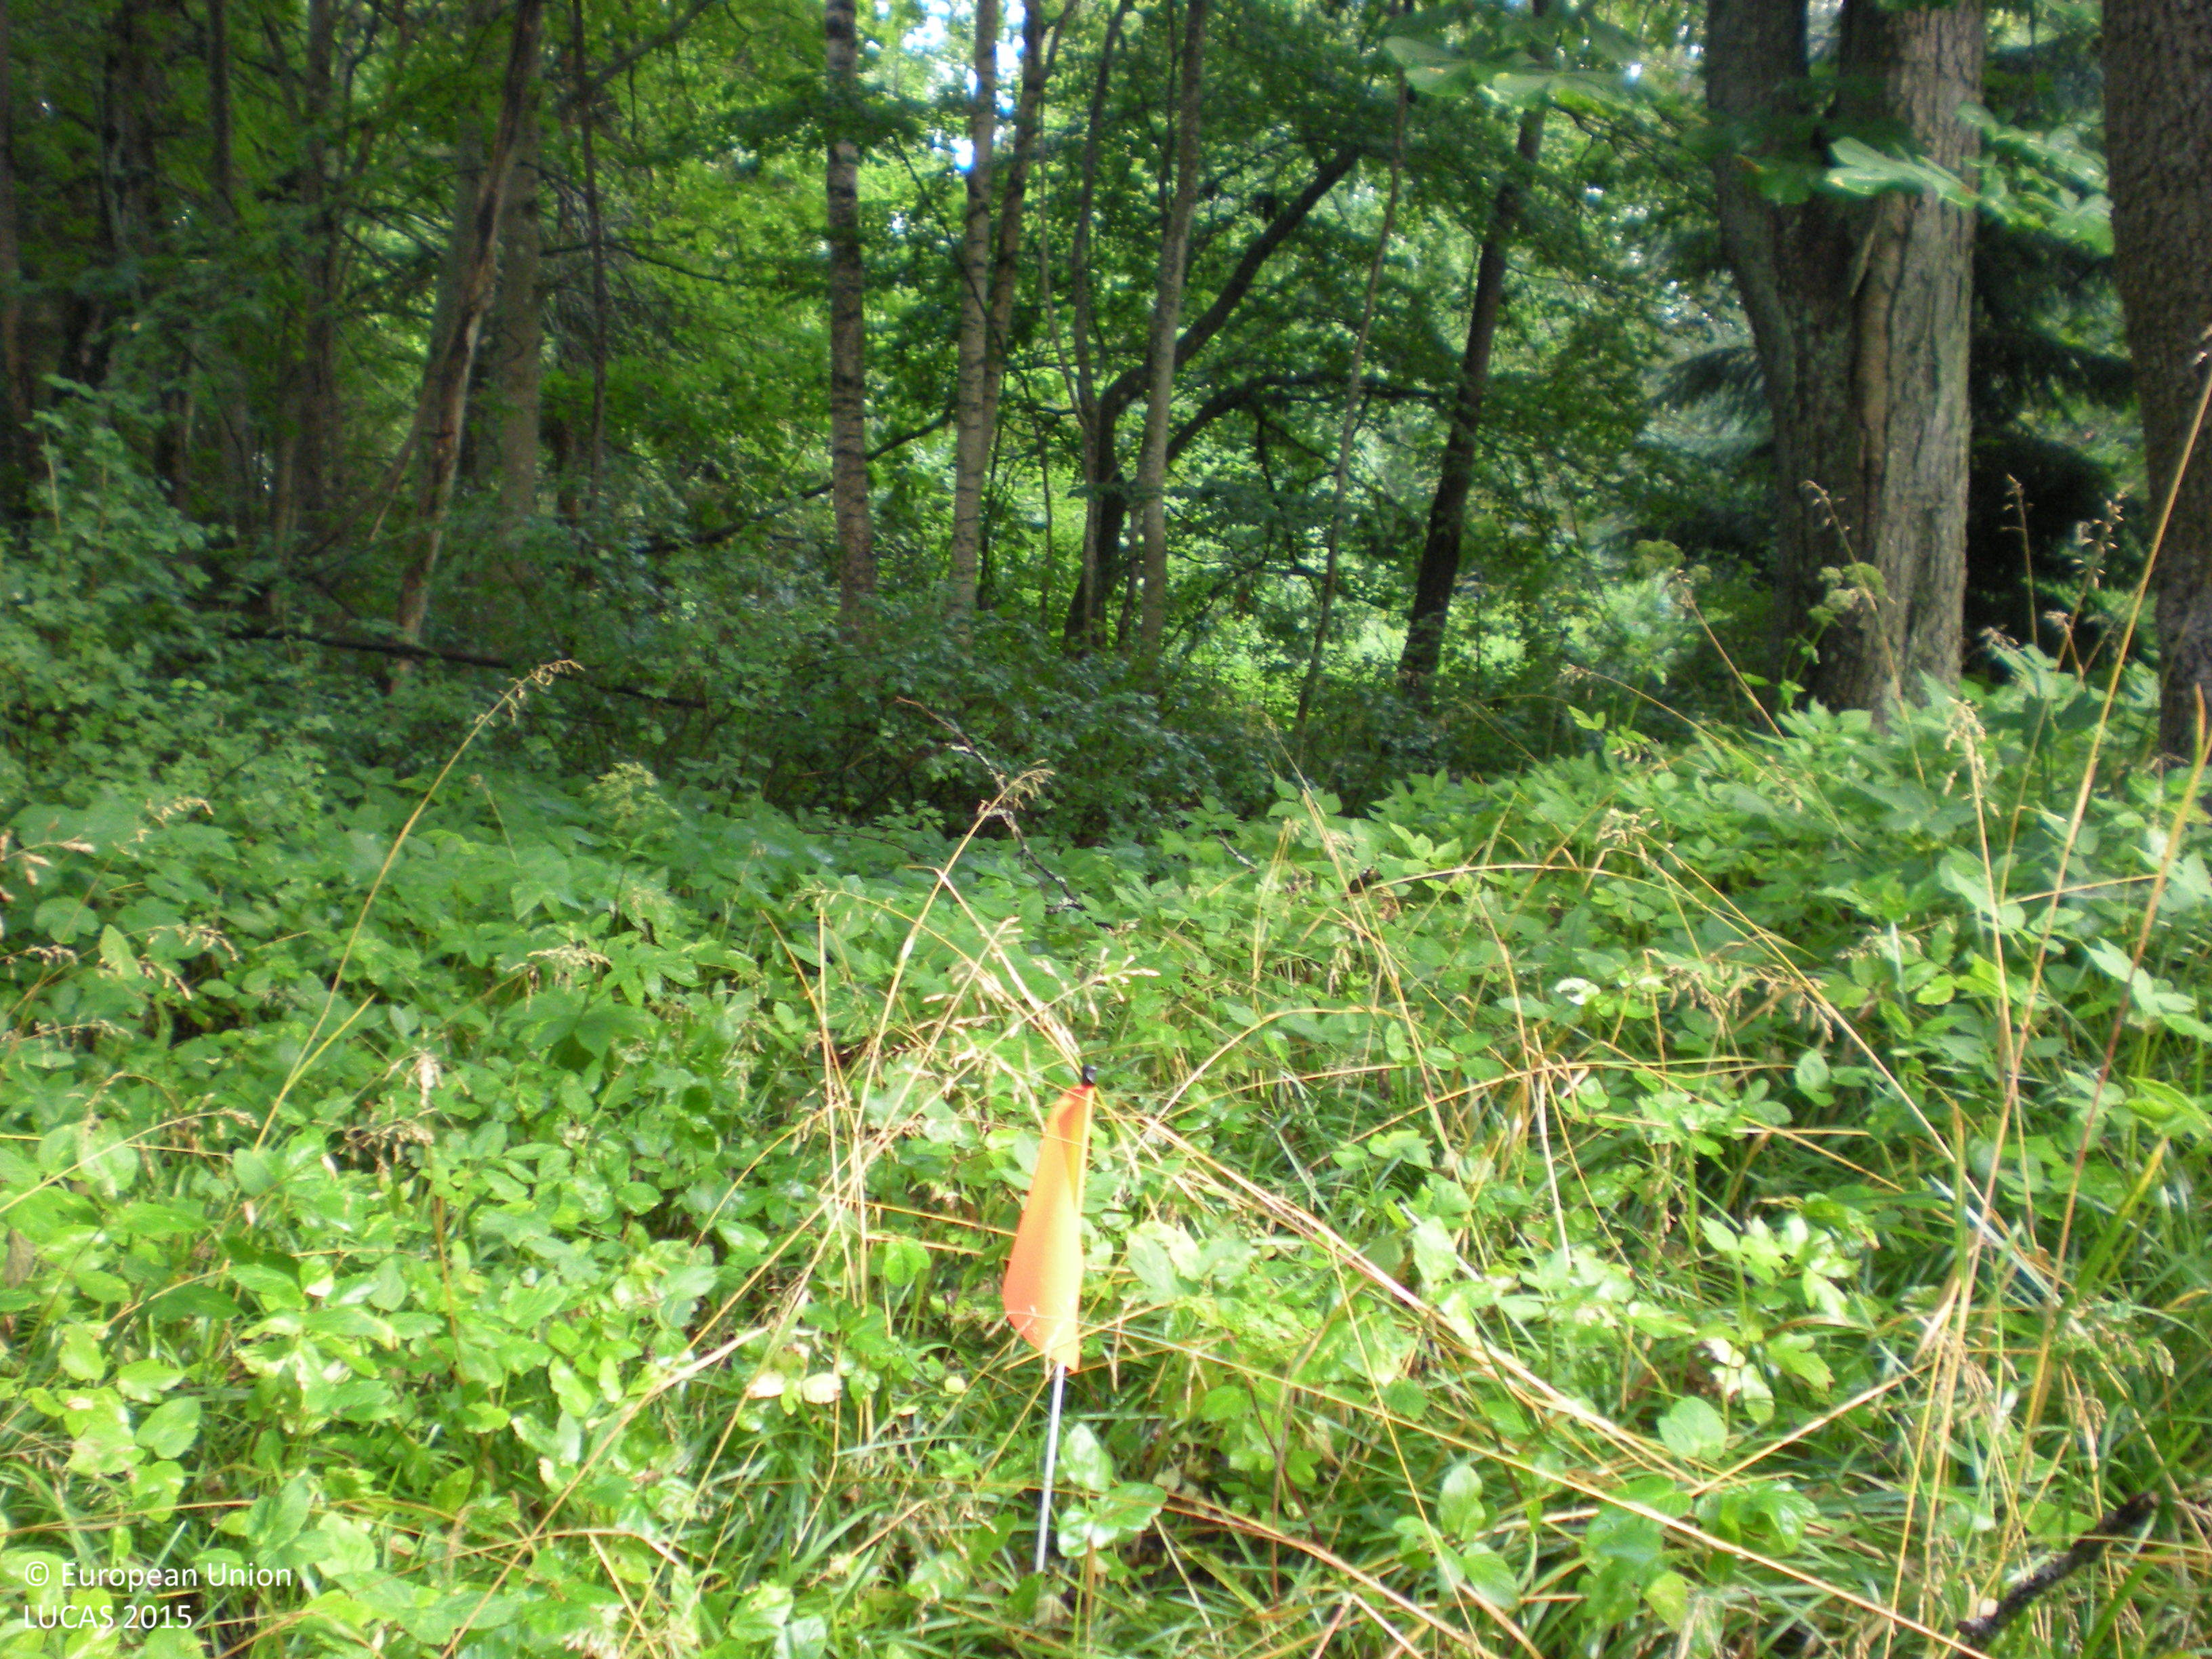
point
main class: Woodland
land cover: Broadleaved woodland
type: boreal forest
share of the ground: > 75 %
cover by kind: broadleaved forest trees 50 %, herbaceous plants 30 %, coniferous forest trees 10 %, lichens and mosses 5 %, unconsolidated bare surface 5 %
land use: Forestry
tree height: > 5 m
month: August
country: SE
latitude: 60.7009
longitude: 17.2251
